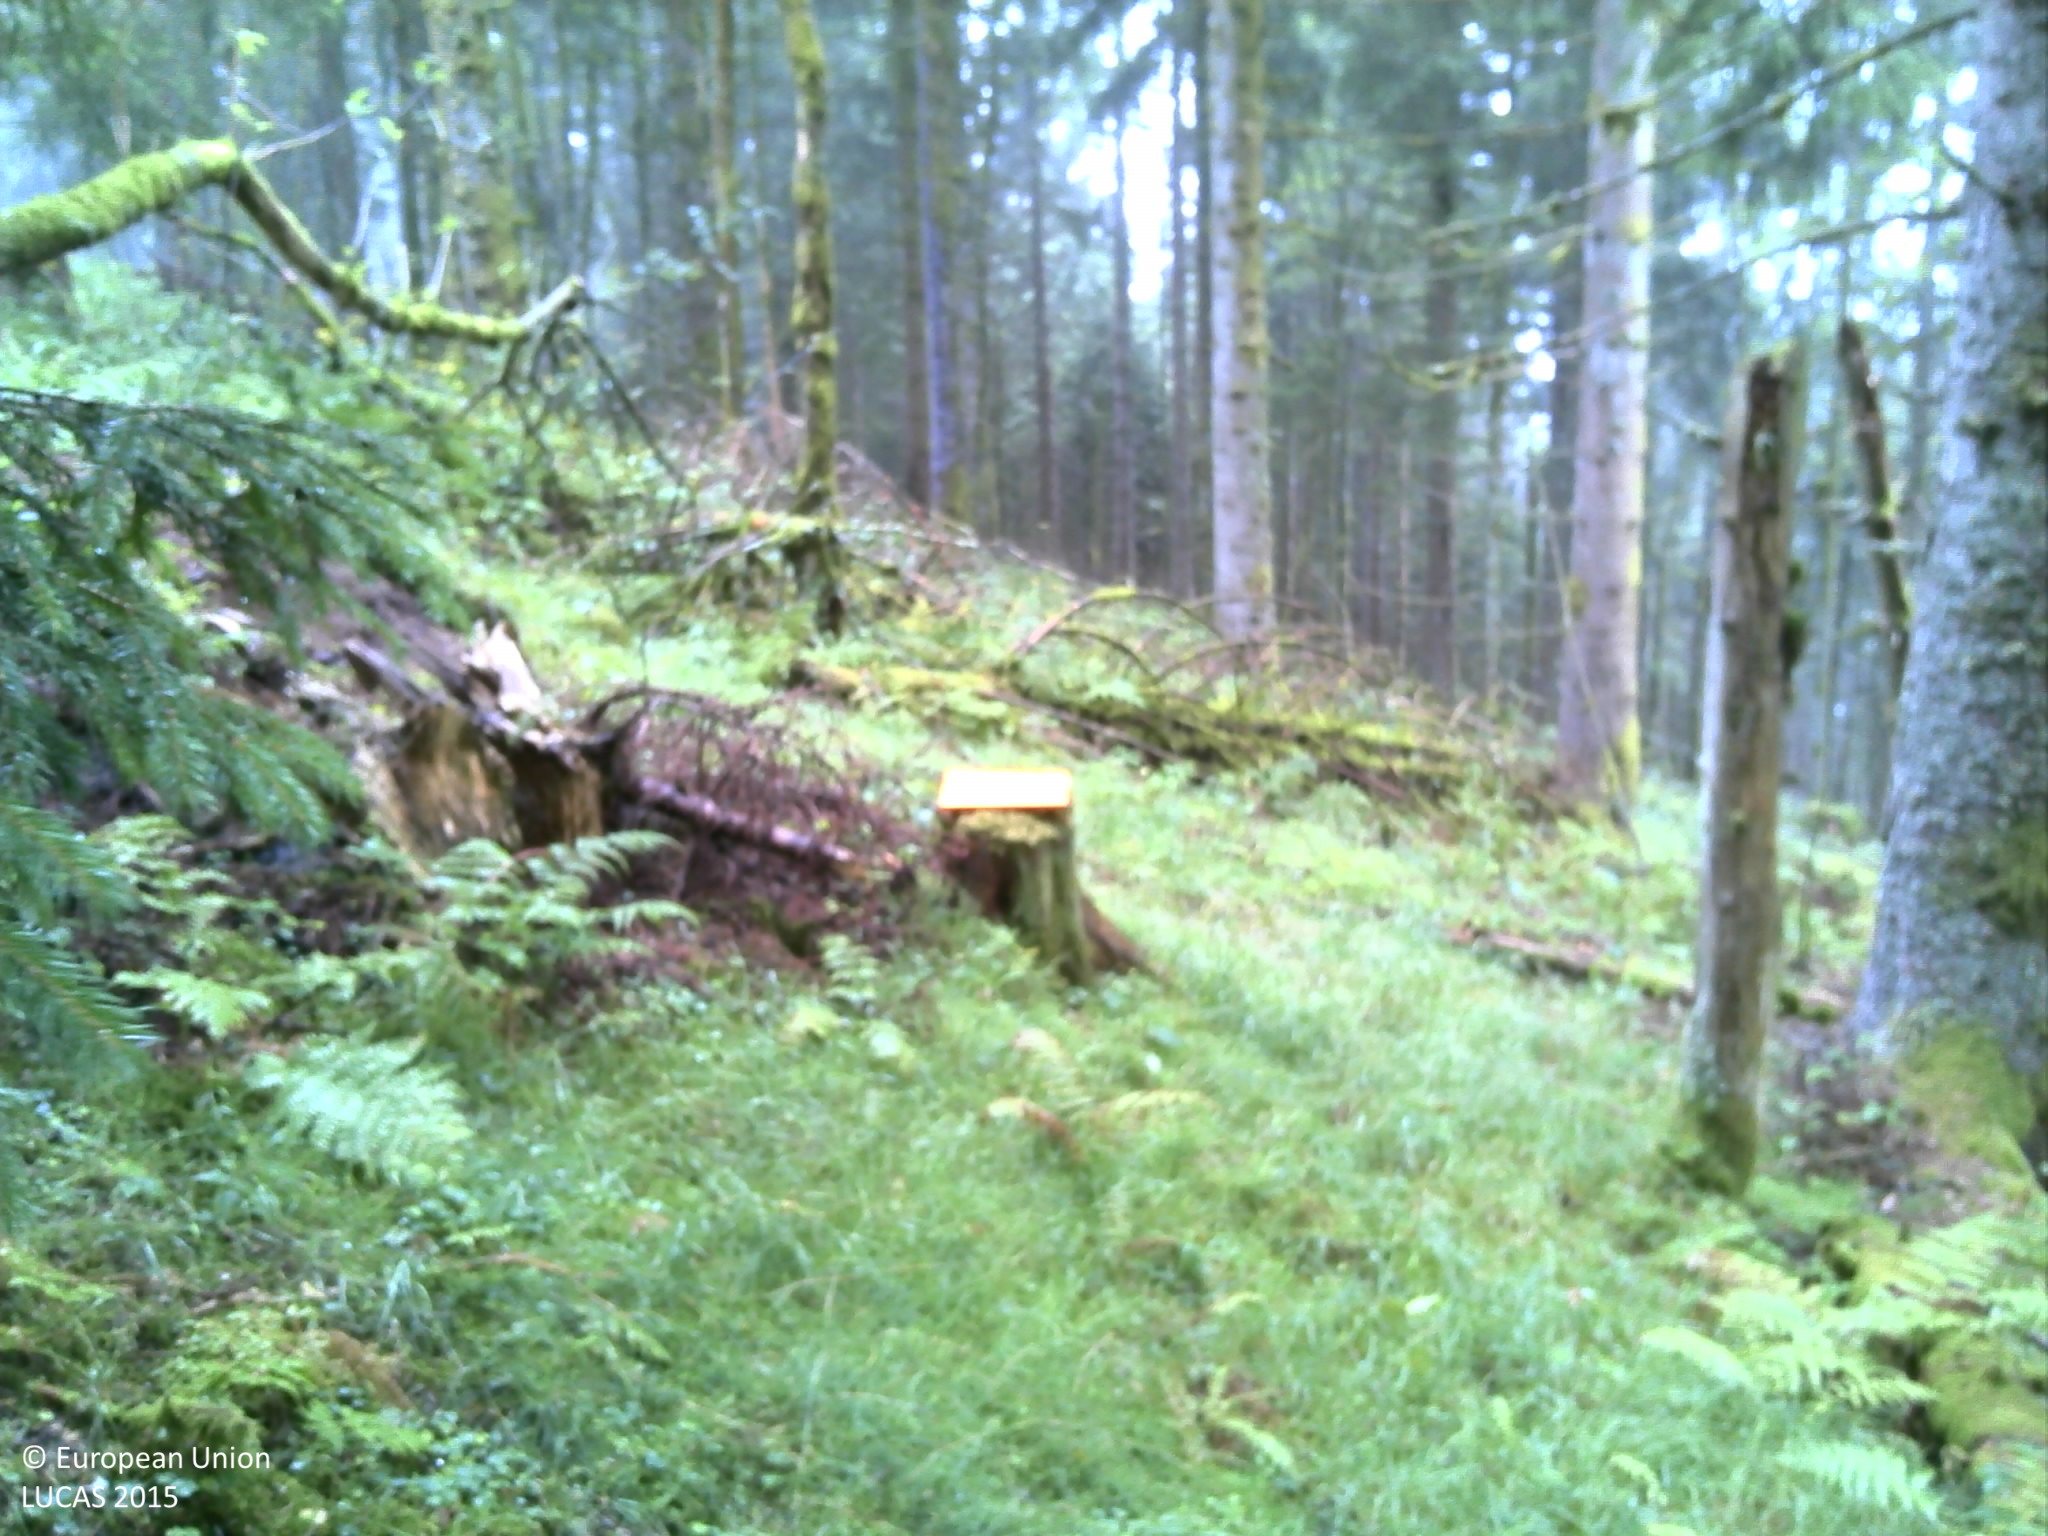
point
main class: Woodland
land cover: Spruce dominated coniferous woodland
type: alpine coniferous forest
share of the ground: > 75 %
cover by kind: coniferous forest trees 90 %, herbaceous plants 10 %
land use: Forestry
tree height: > 5 m
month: August
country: FR
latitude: 47.9806
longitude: 6.8527
